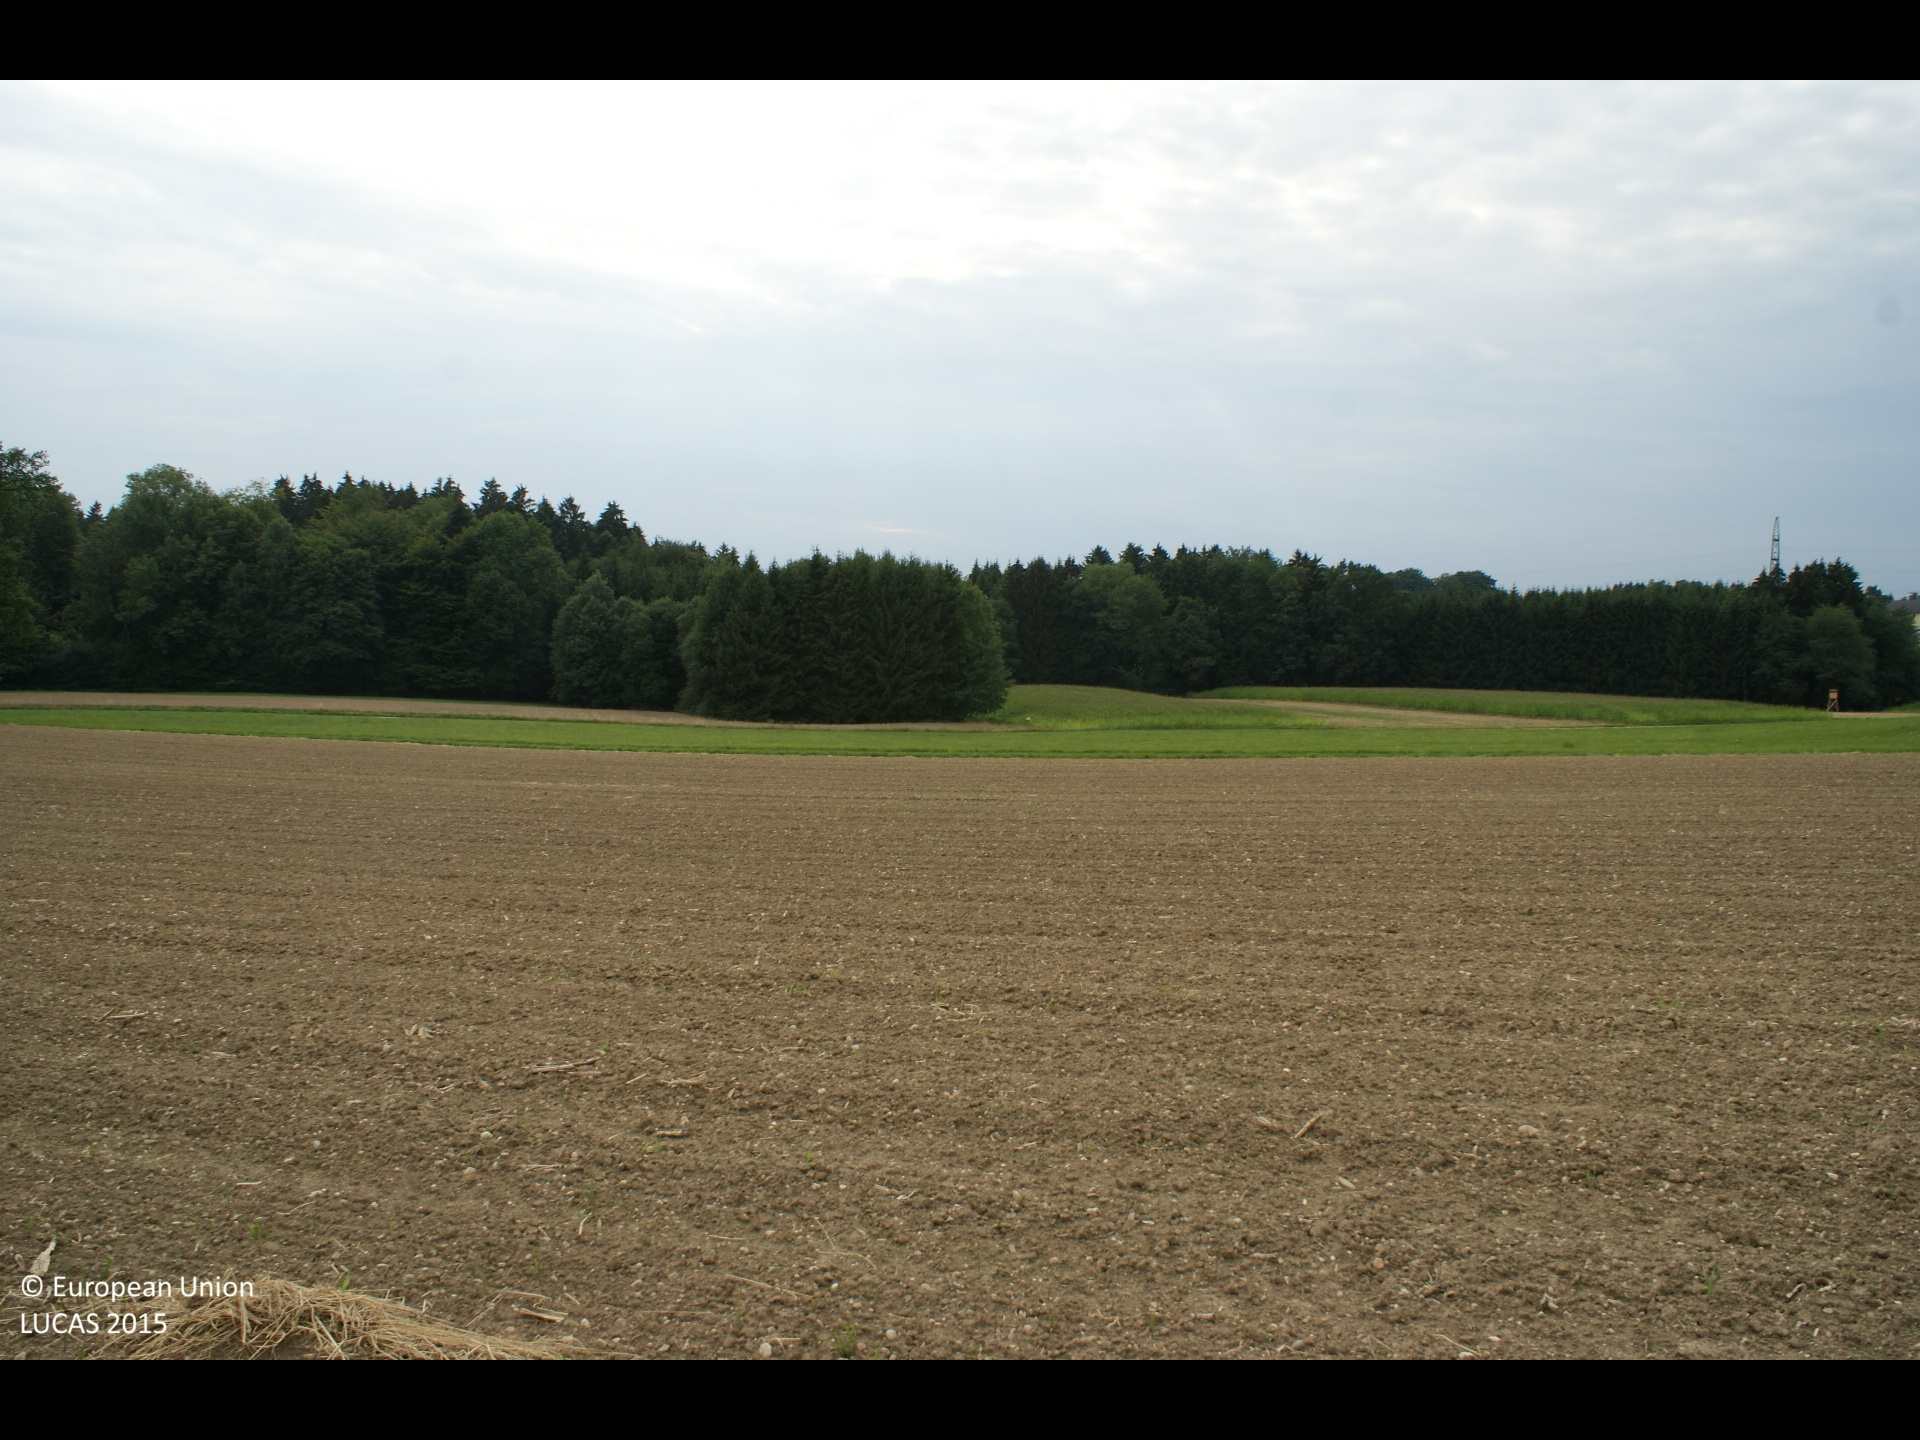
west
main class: Cropland
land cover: Clovers
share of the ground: > 75 %
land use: Agriculture (excluding fallow land and kitchen gardens)
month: August
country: AT
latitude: 47.9837
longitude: 13.6301
